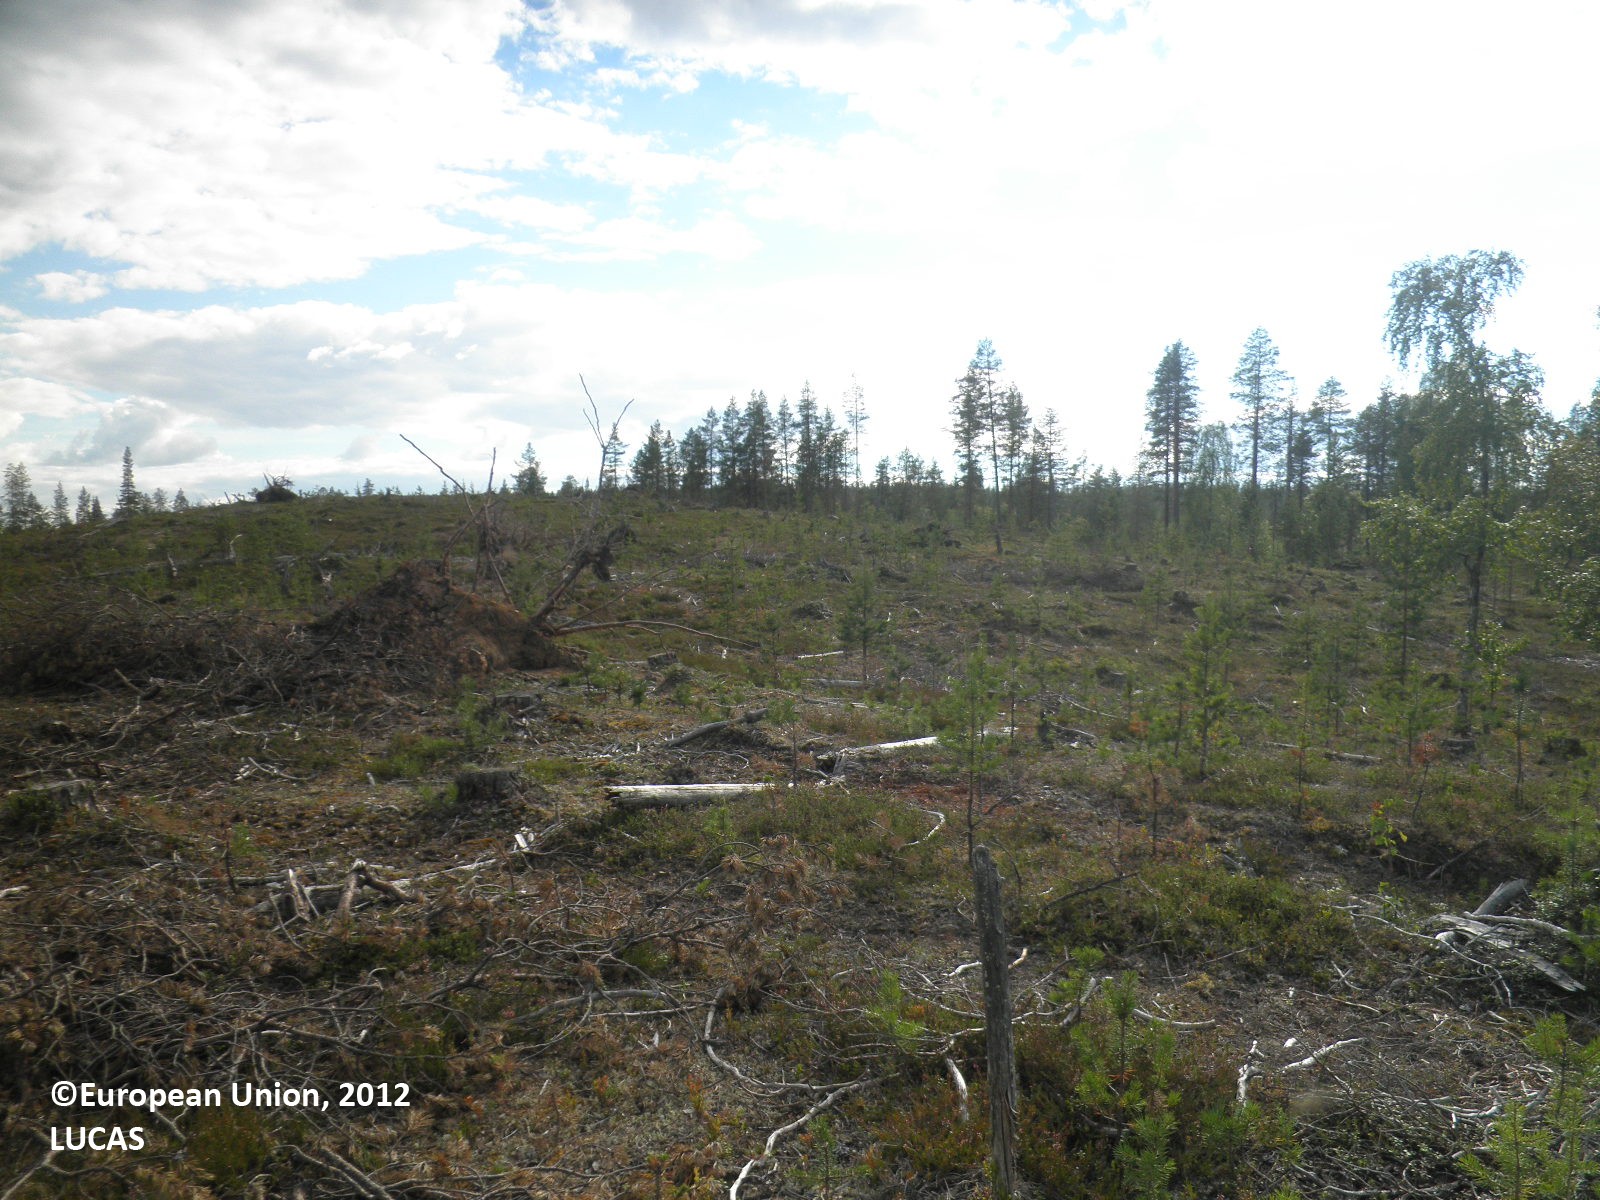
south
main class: Grassland
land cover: Grassland with sparse tree/shrub cover
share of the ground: > 75 %
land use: Forestry
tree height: < 5 m
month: August
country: FI
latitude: 67.4989
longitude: 26.3412
